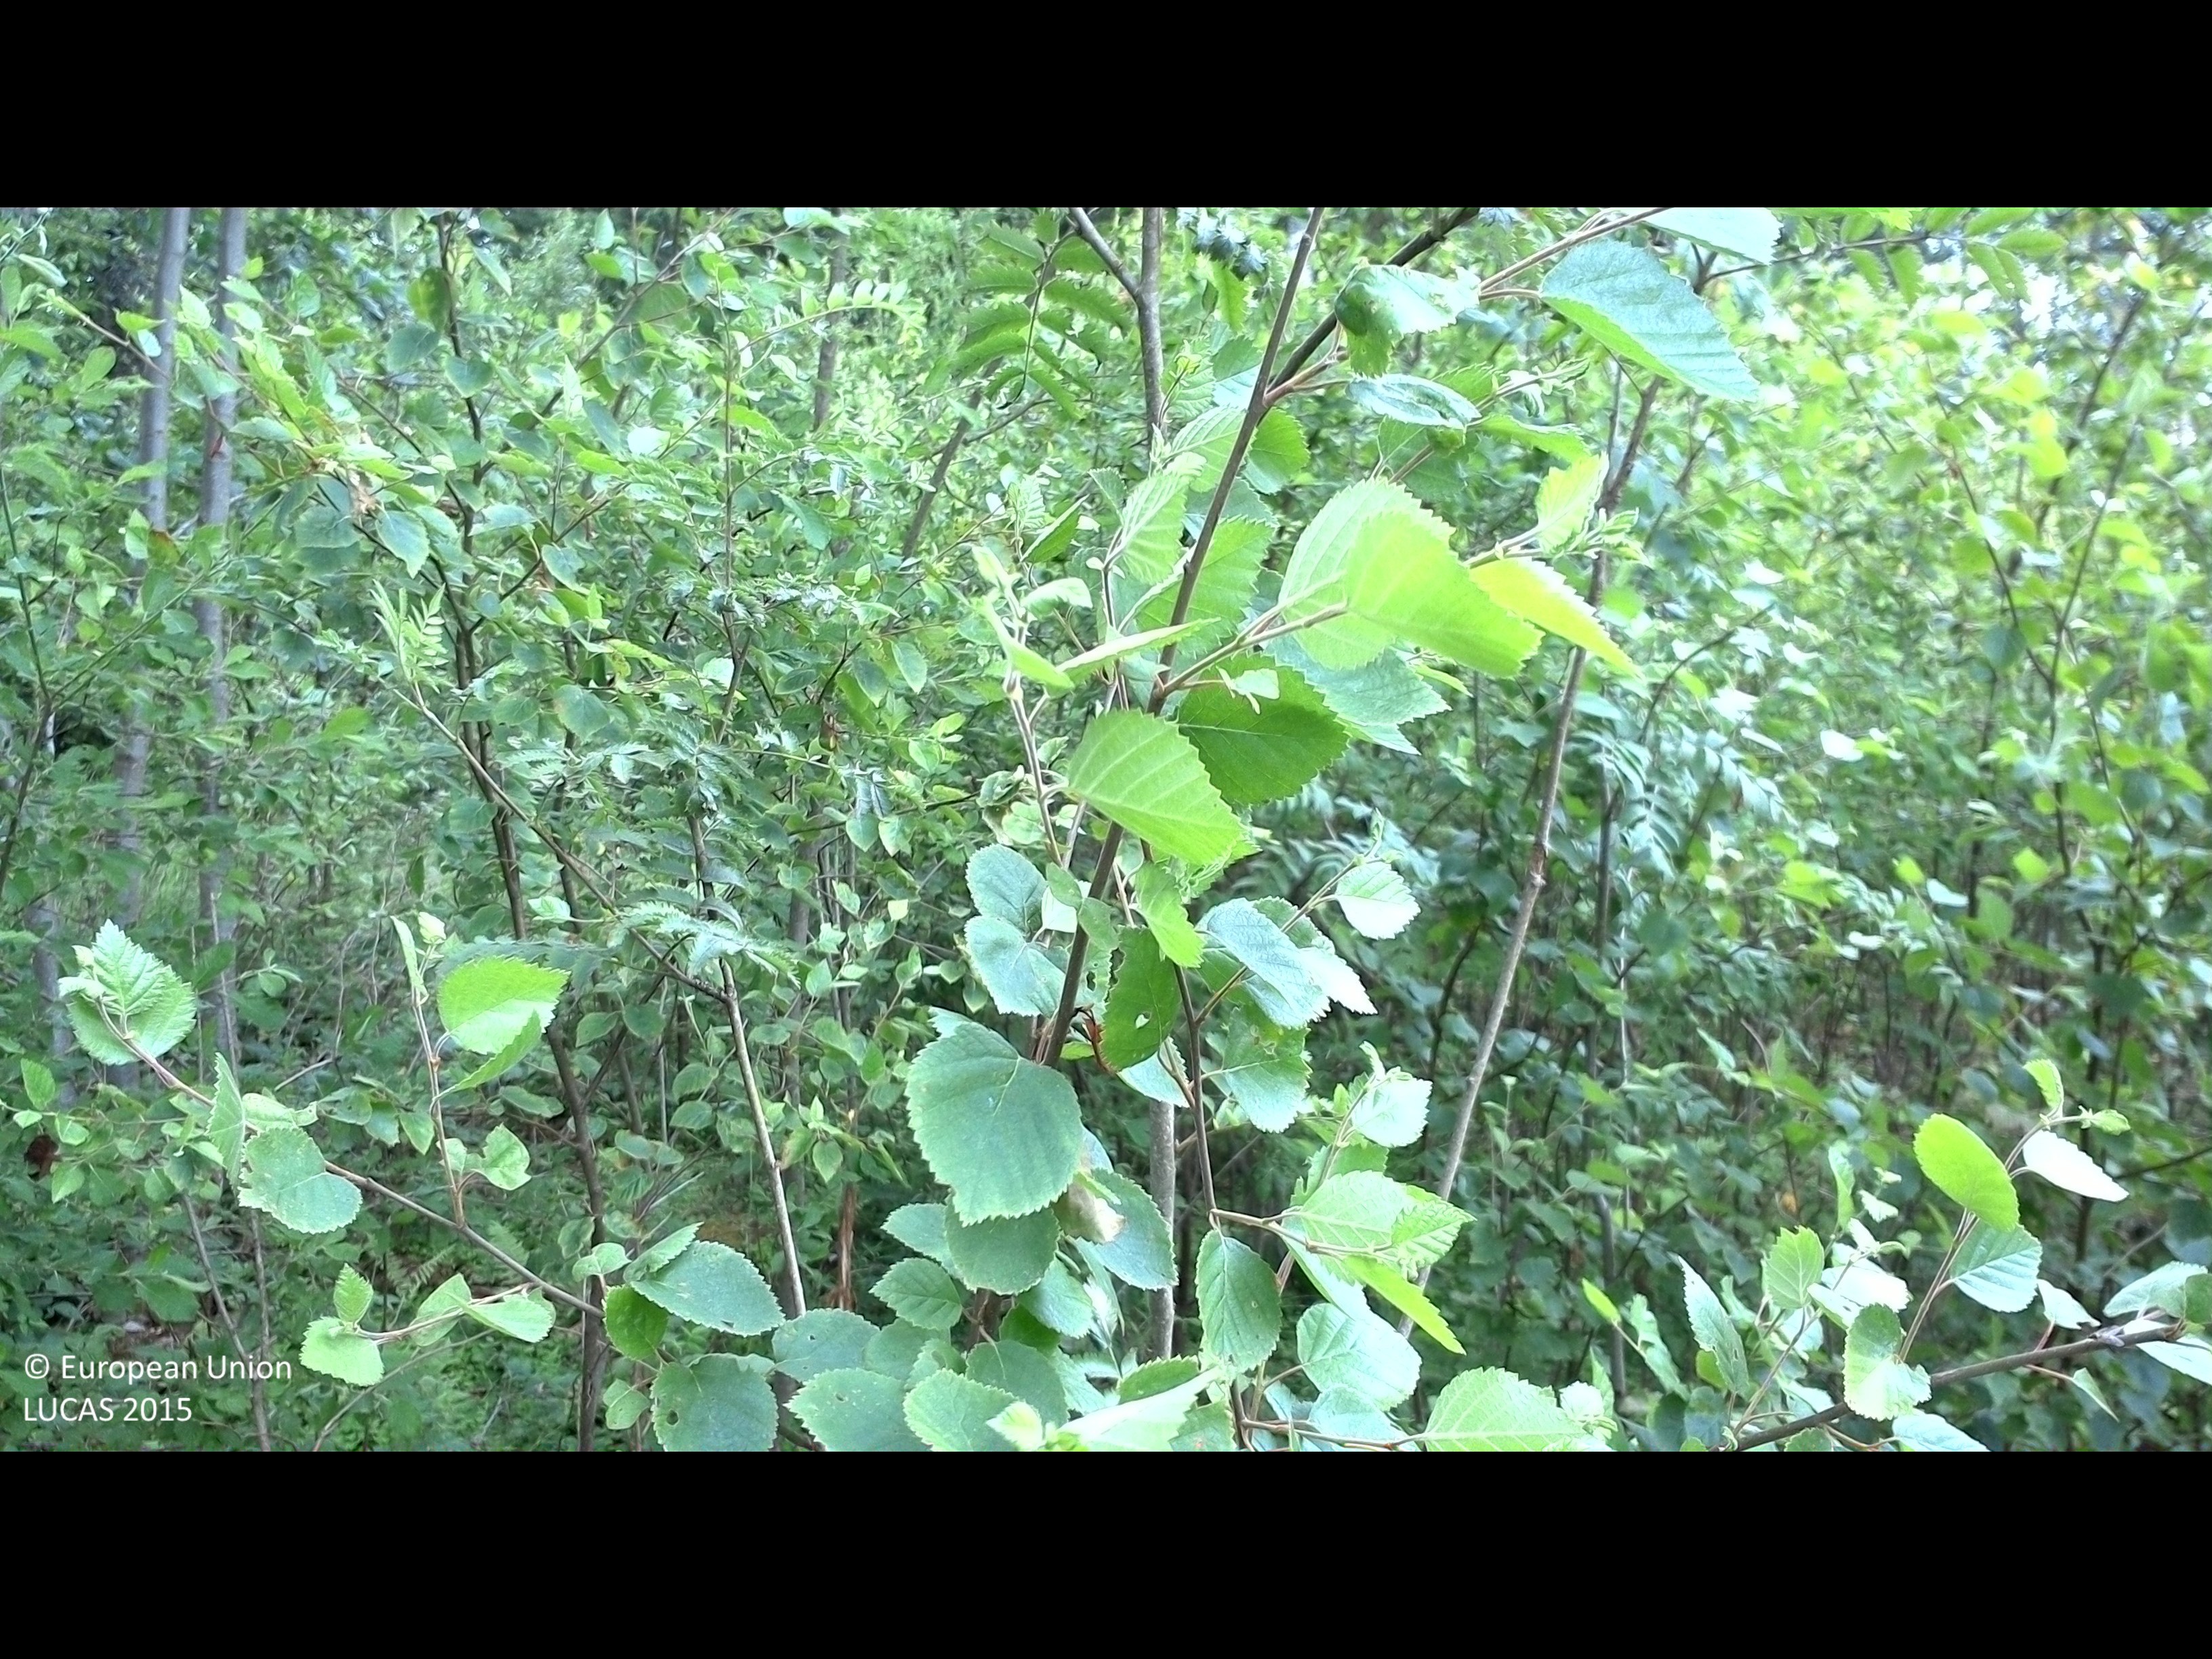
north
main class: Woodland
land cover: Broadleaved woodland
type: boreal forest
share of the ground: 50 - 75 %
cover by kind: broadleaved forest trees 65 %, shrubs 20 %, herbaceous plants 10 %, lichens and mosses 5 %
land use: Forestry
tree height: < 5 m
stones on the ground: < 10 %
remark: Clear cut
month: July
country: SE
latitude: 56.3735
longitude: 15.1312
